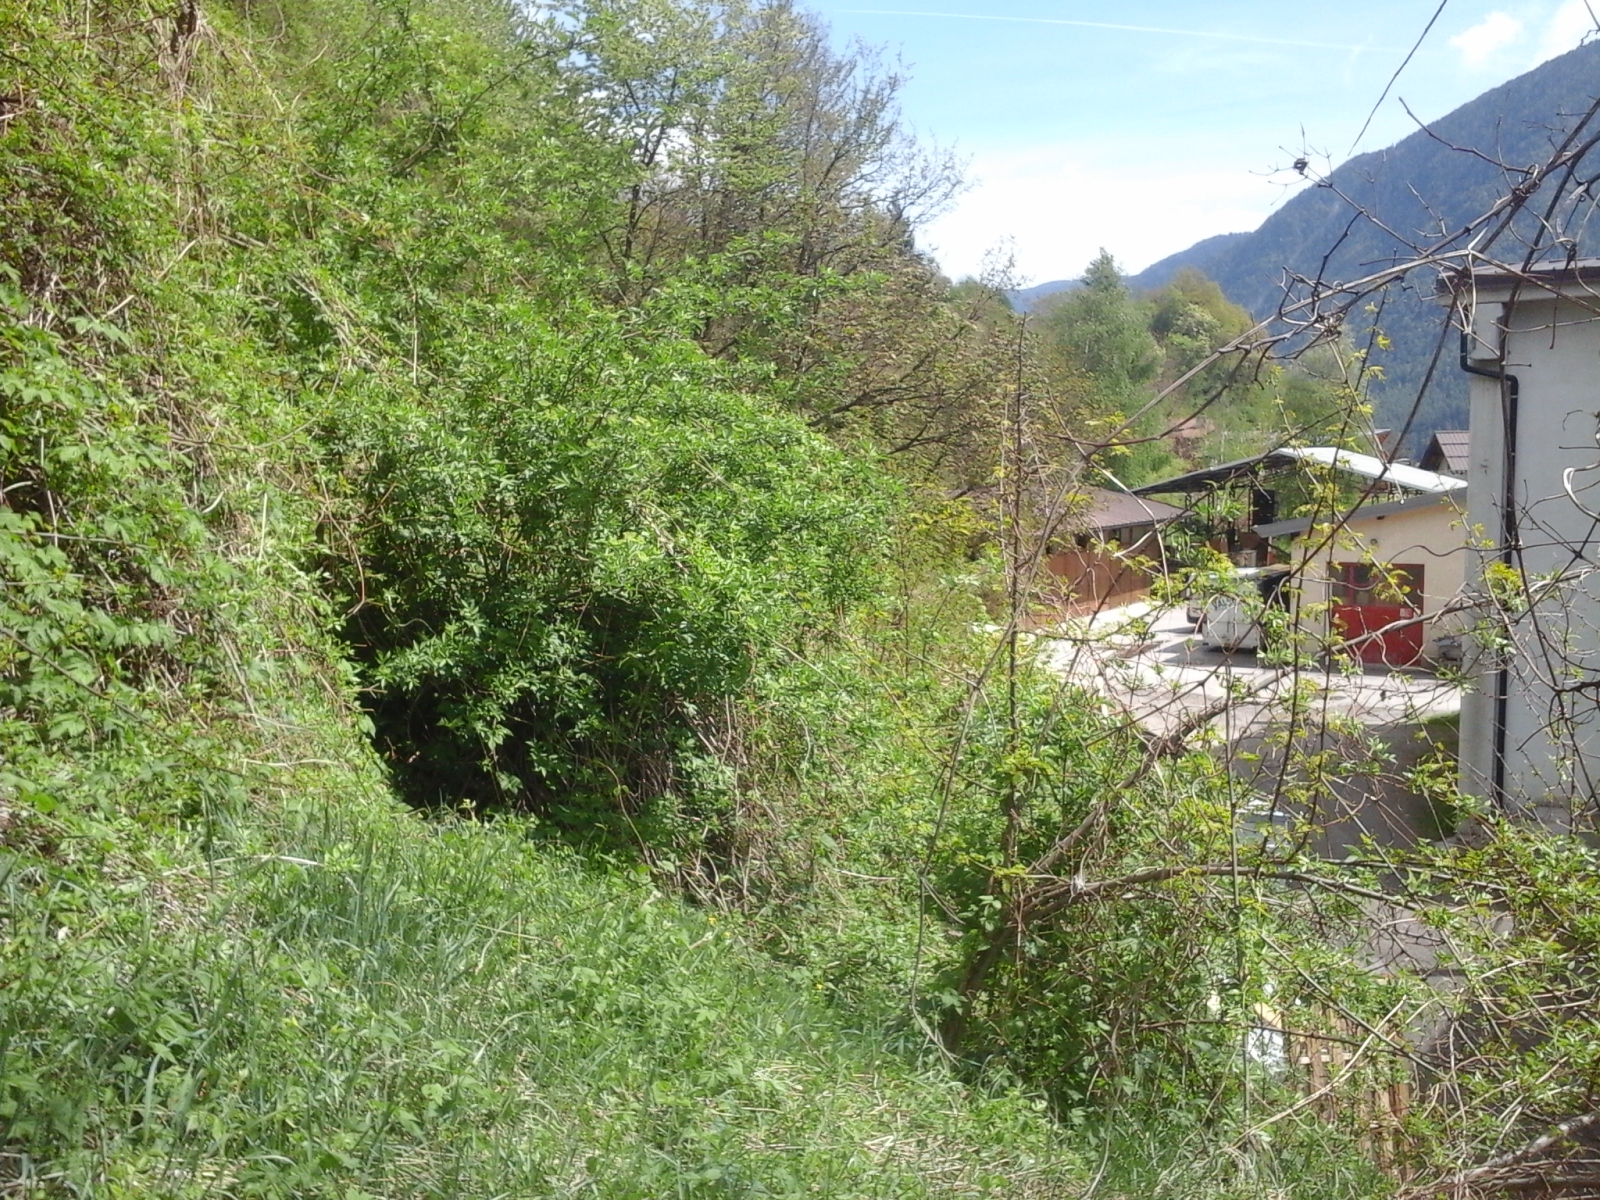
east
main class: Woodland
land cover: Broadleaved woodland
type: exotic forest
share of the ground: > 75 %
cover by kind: broadleaved forest trees 100 %
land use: Forestry
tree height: > 5 m
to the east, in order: Broadleaved woodland; Artificial constructions in urban areas; Rivers and streams; Artificial constructions in urban areas; Grassland without tree/shrub cover
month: May
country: IT
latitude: 46.3297
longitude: 10.8692
